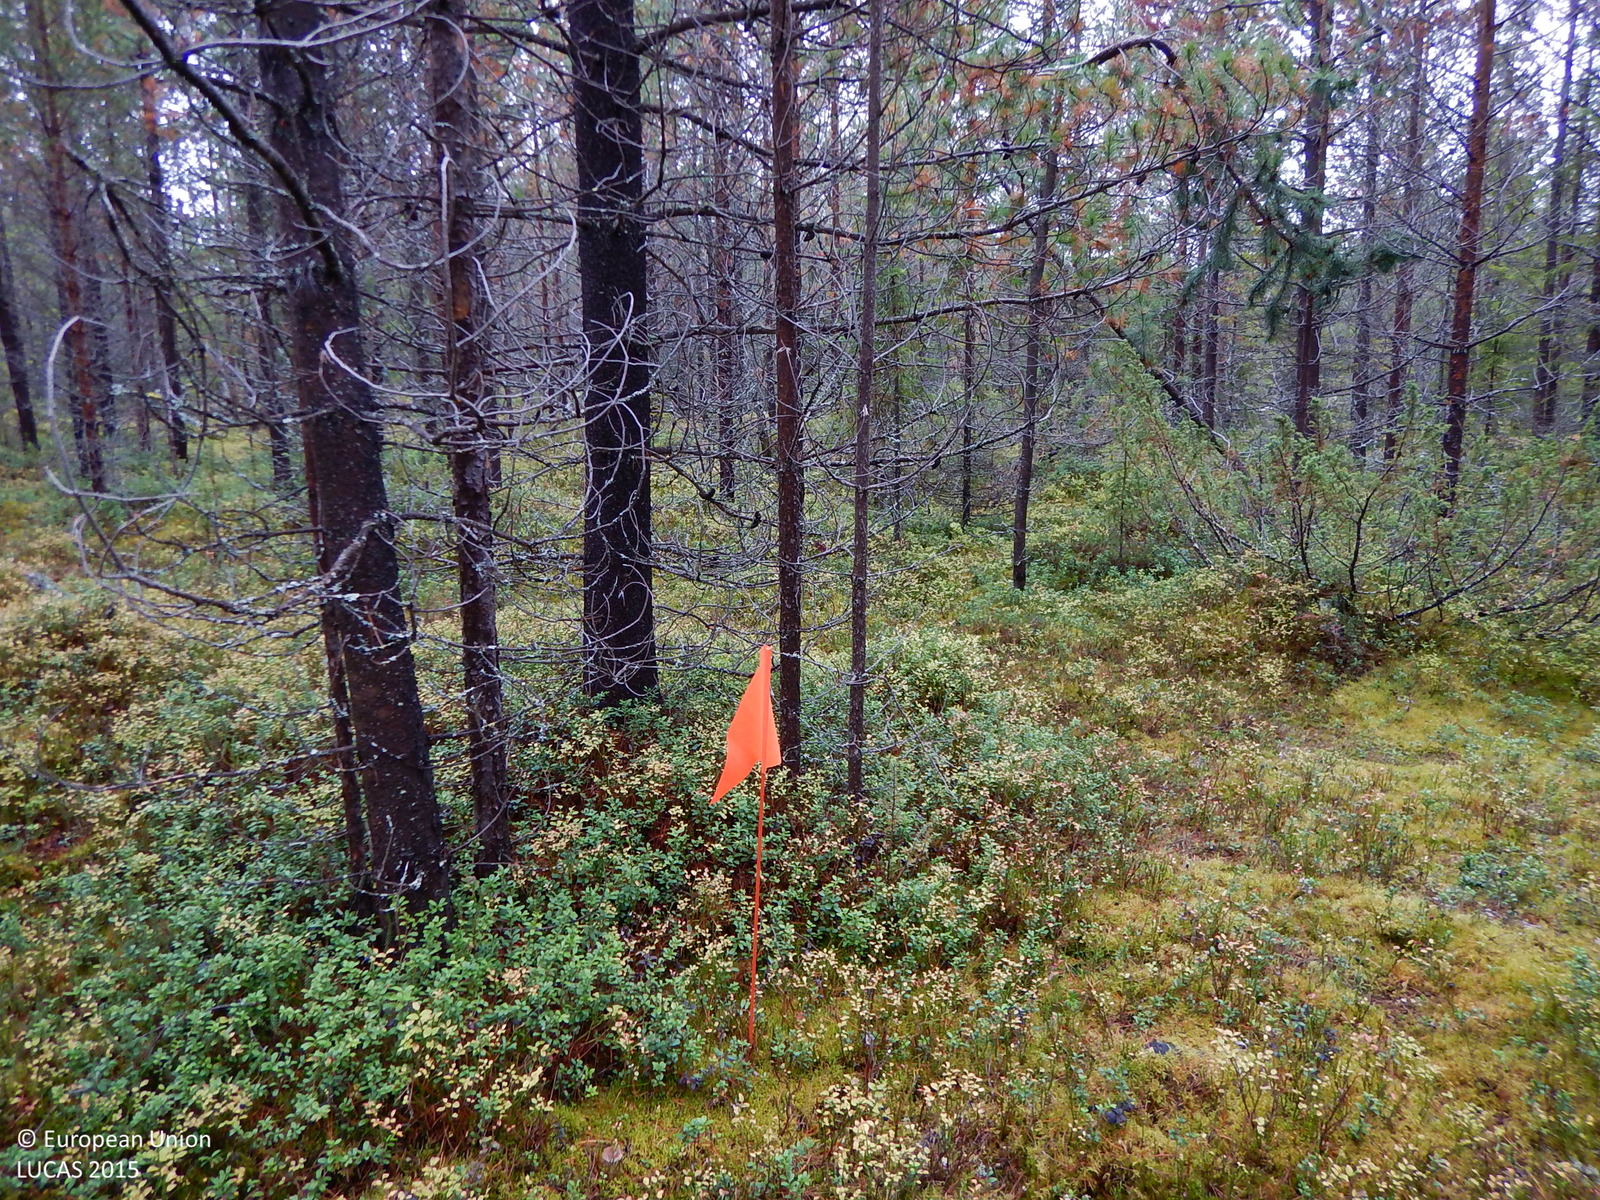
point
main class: Woodland
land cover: Pine dominated coniferous woodland
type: exotic forest
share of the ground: 50 - 75 %
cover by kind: coniferous forest trees 60 %, shrubs 15 %, lichens and mosses 15 %, herbaceous plants 10 %
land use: Forestry
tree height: > 5 m
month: September
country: SE
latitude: 65.2601
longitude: 19.1935
